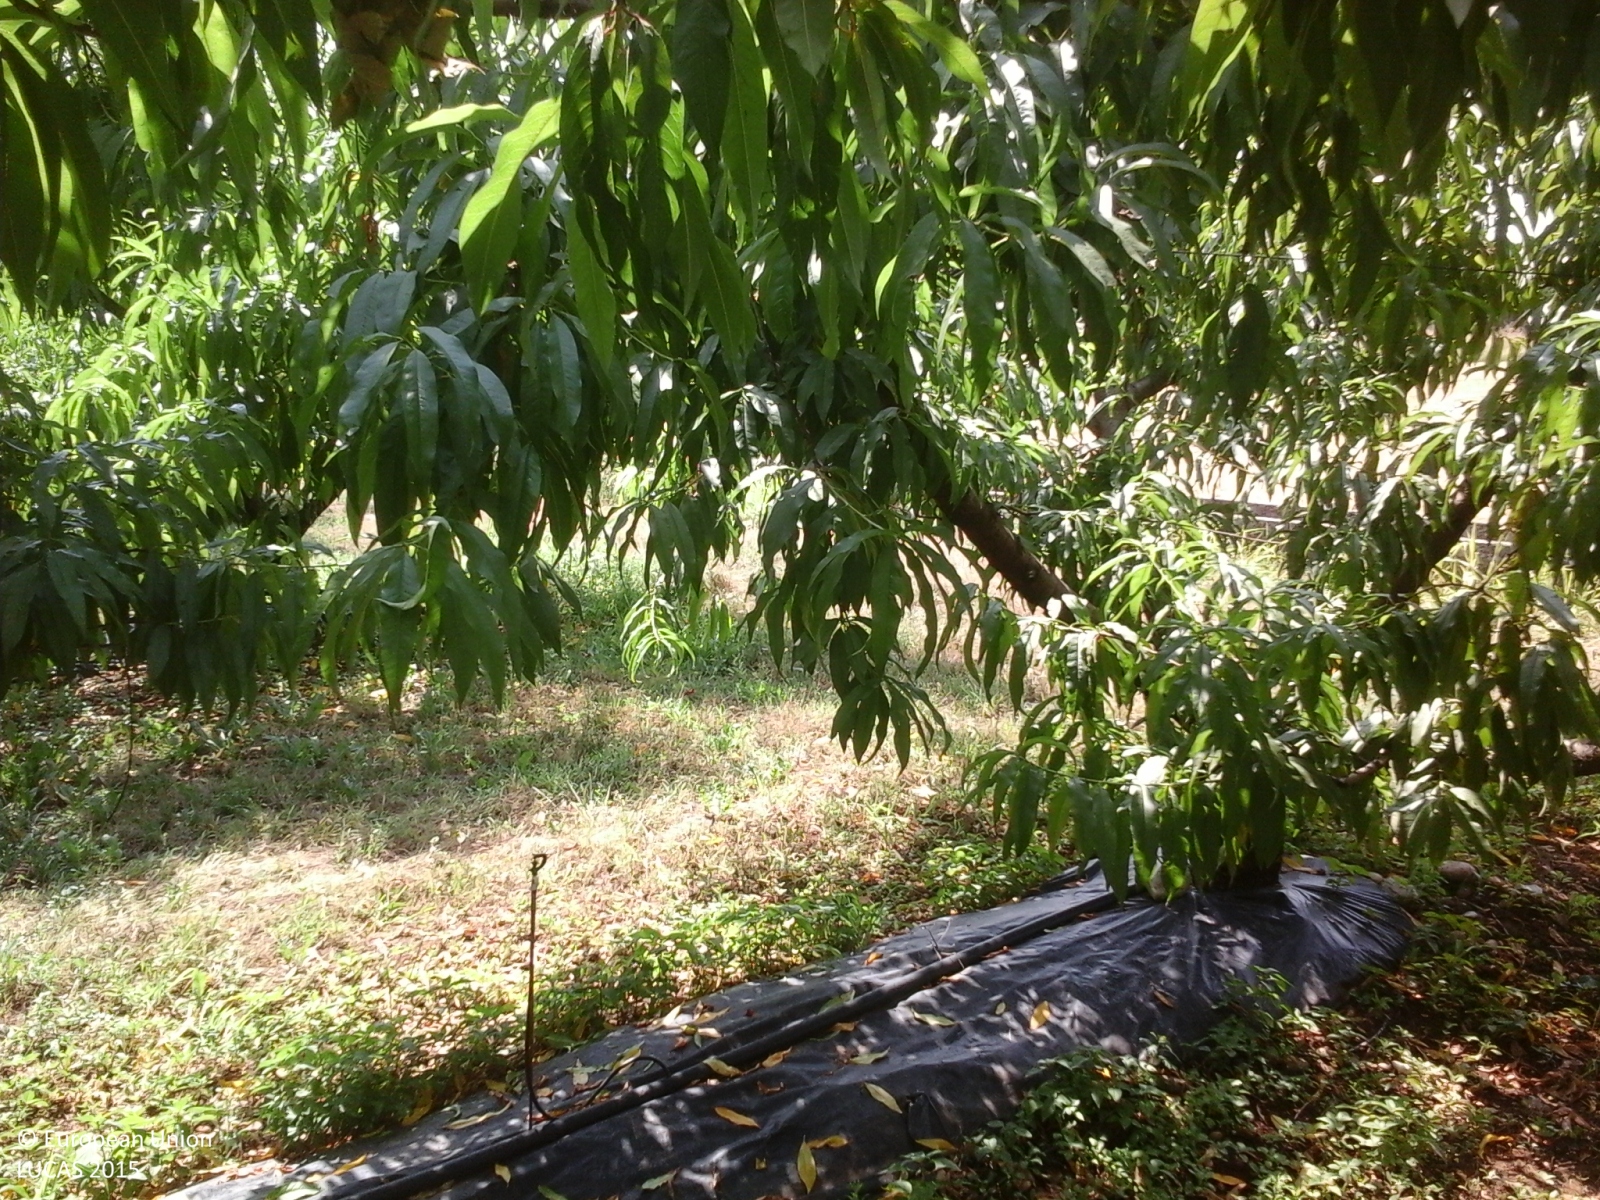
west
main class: Cropland
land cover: Other fruit trees and berries
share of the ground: > 75 %
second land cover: Grassland without tree/shrub cover
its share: > 75 %
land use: Agriculture (excluding fallow land and kitchen gardens)
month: July
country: IT
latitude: 45.2854
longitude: 10.7508
